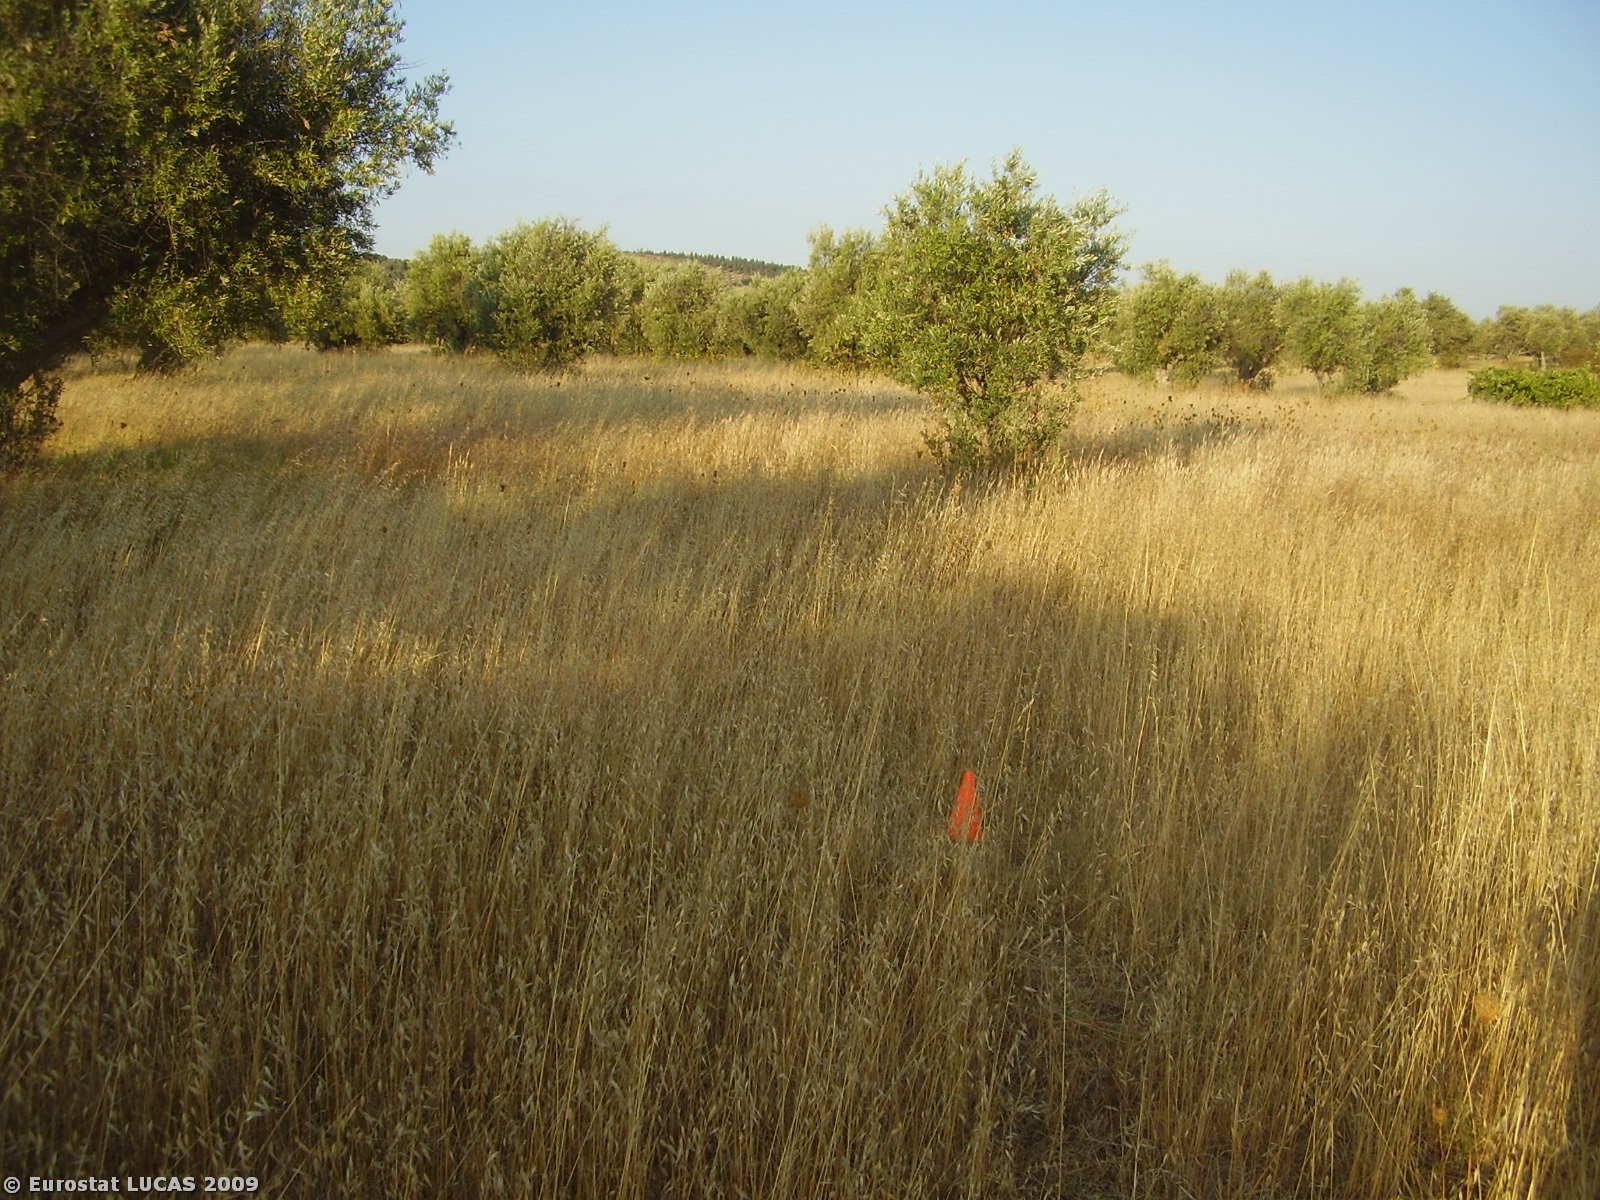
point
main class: Cropland
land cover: Olive groves
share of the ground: 10 - 25 %
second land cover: Spontaneously vegetated surfaces
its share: > 75 %
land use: Agriculture (excluding fallow land and kitchen gardens)
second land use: Fallow land
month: August
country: PT
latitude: 38.2063
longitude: -7.7645
